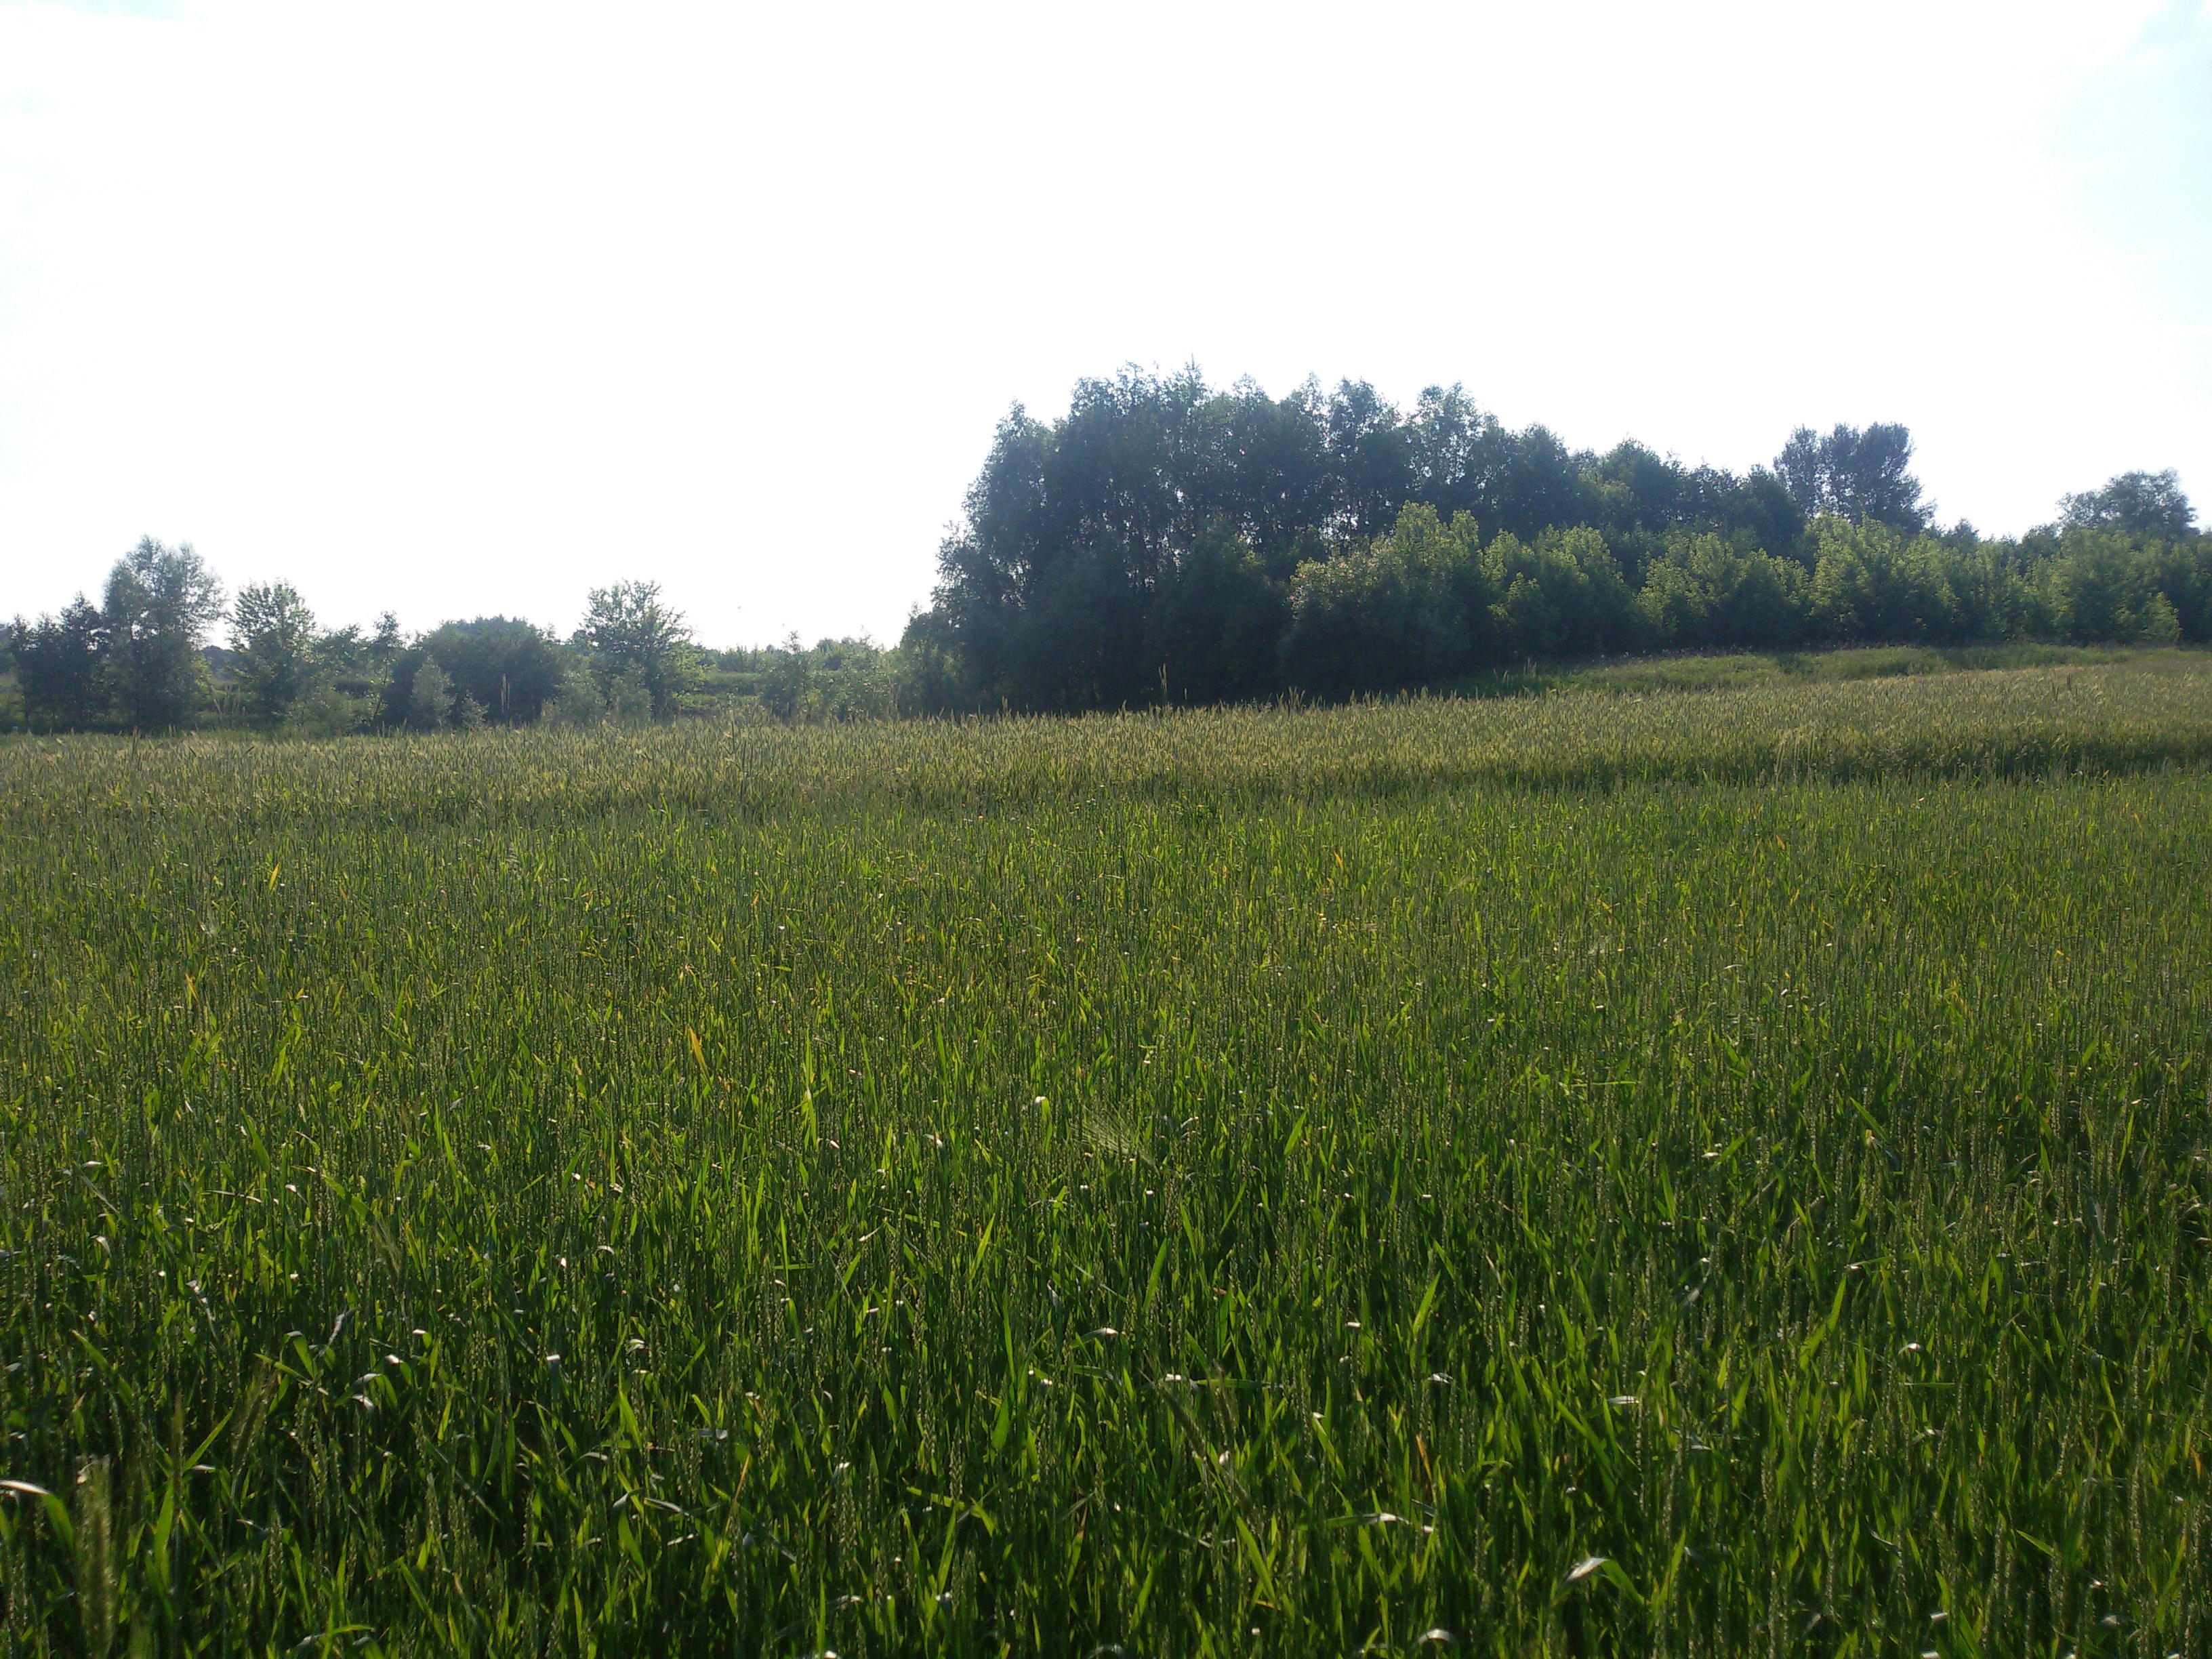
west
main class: Cropland
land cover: Common wheat
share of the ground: > 75 %
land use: Agriculture (excluding fallow land and kitchen gardens)
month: June
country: PL
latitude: 50.0973
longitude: 21.6129
